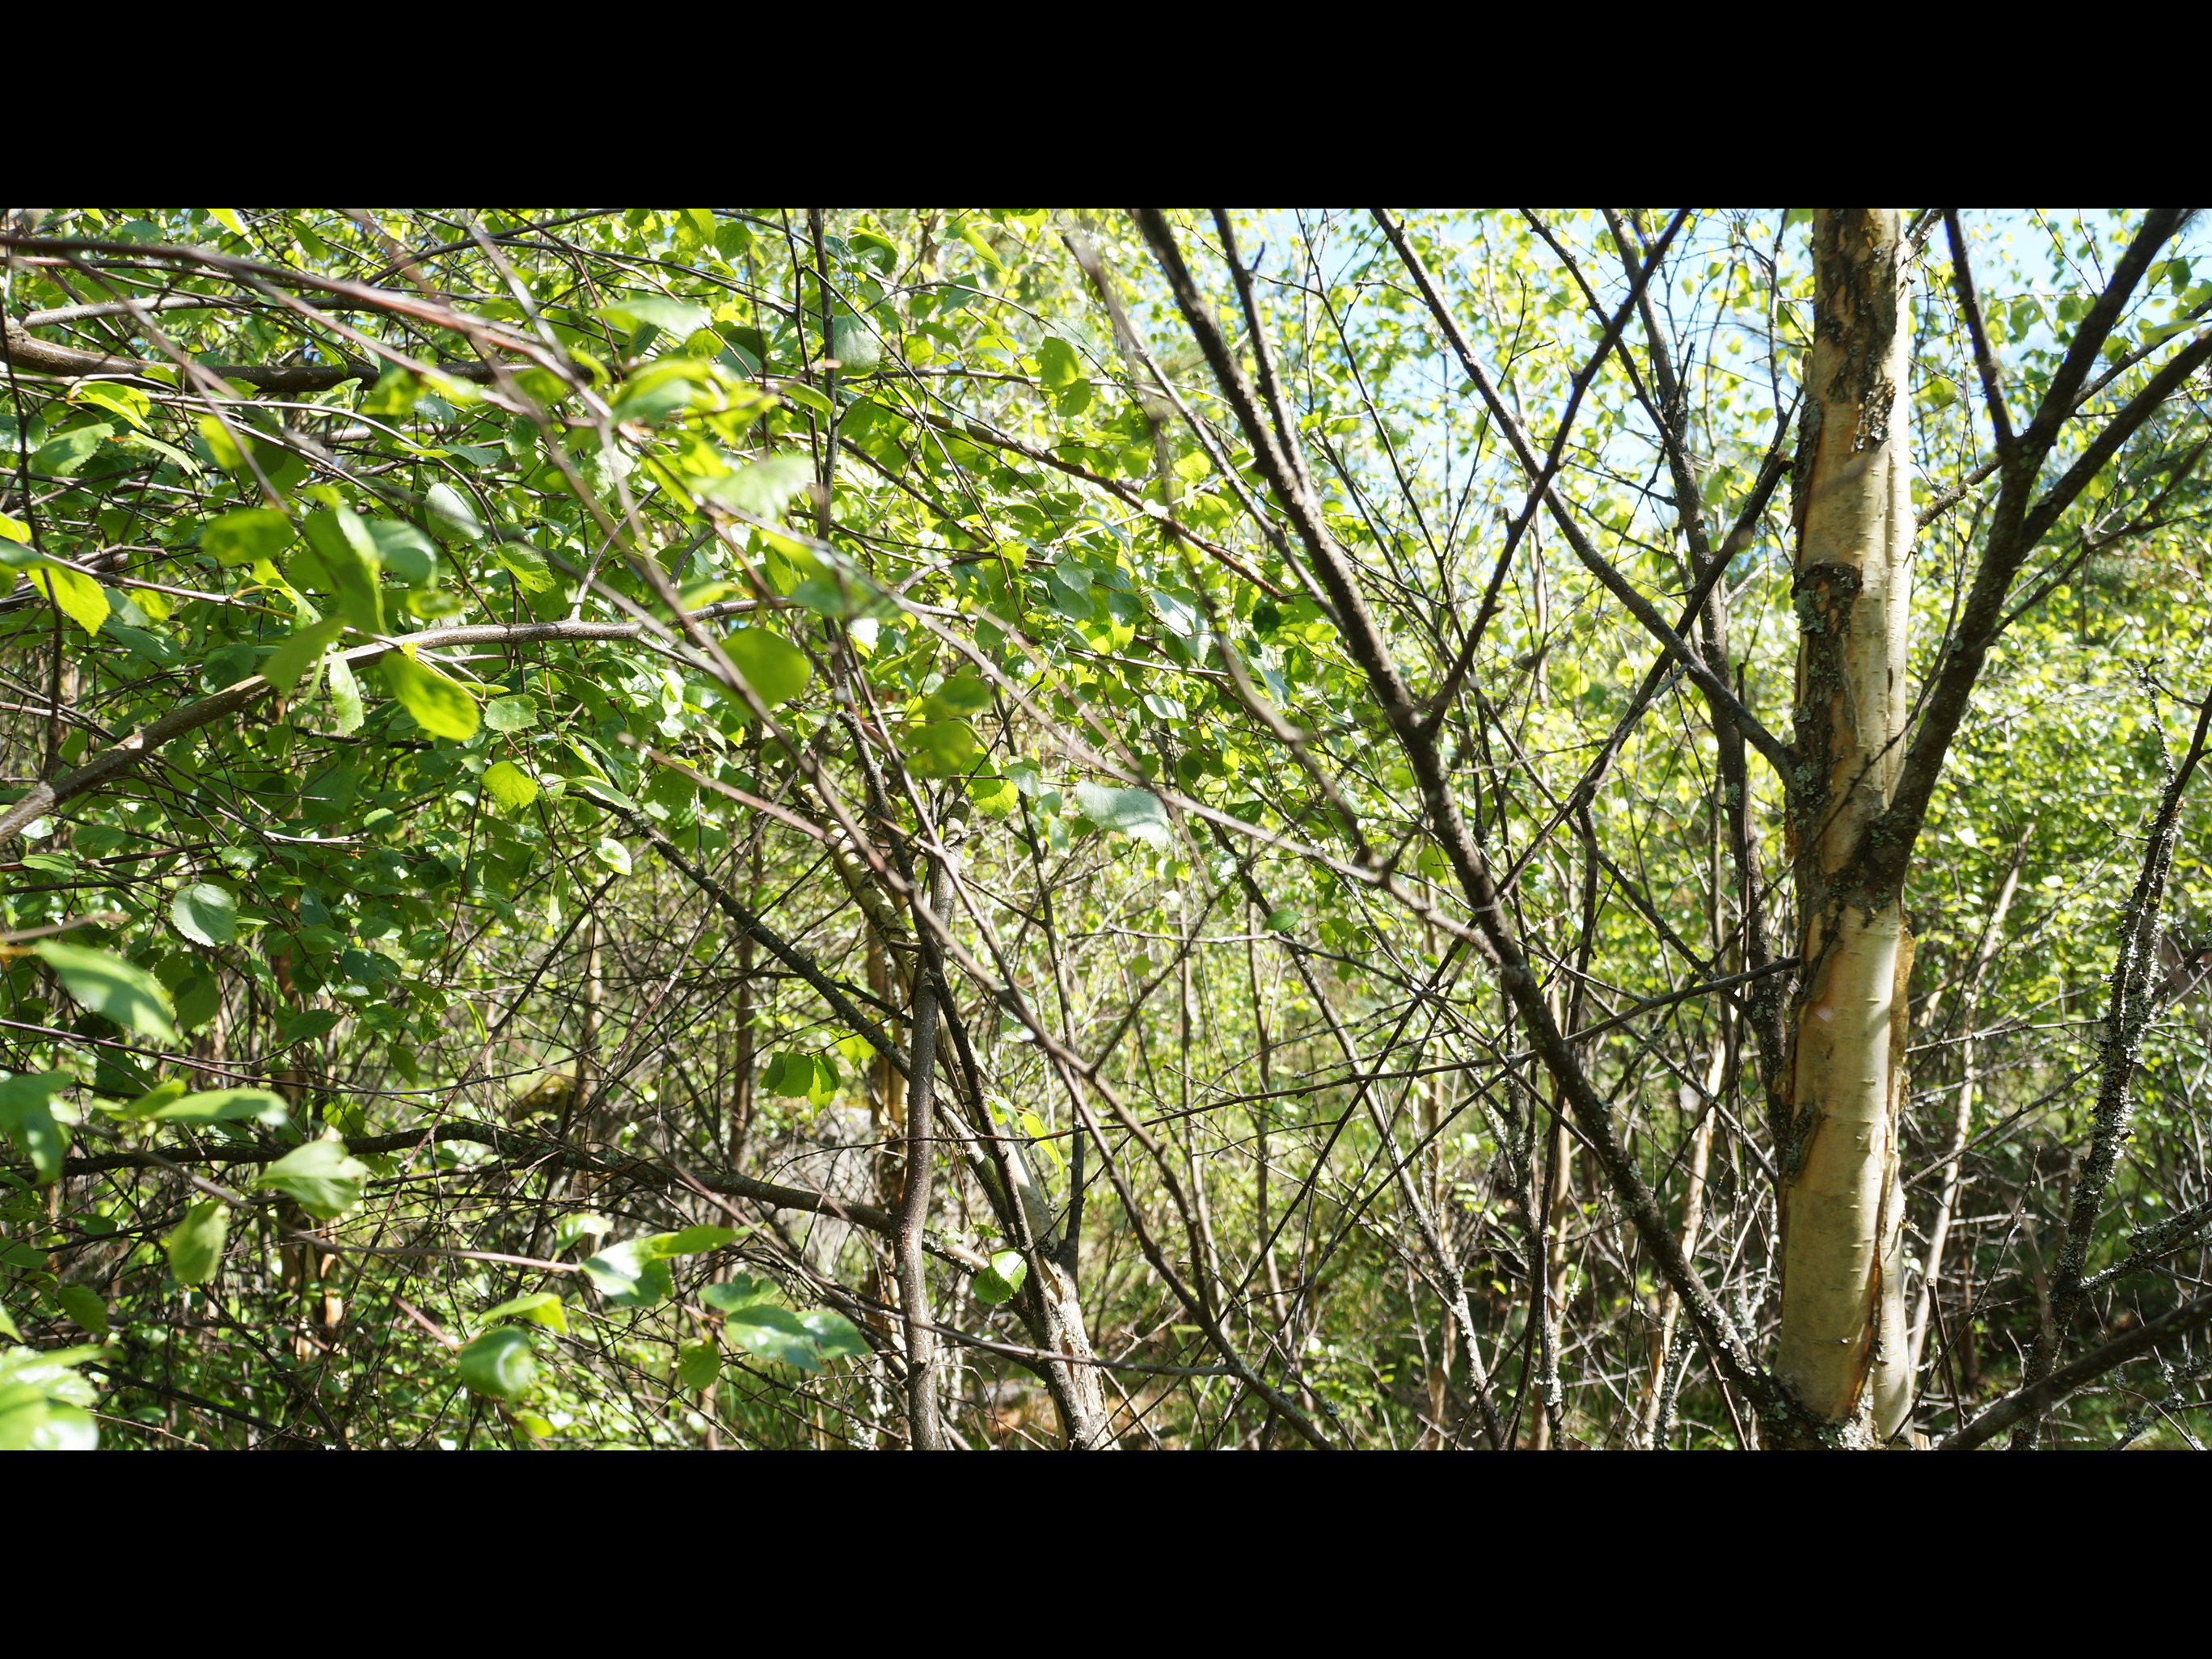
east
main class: Woodland
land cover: Broadleaved woodland
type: boreal forest
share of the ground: > 75 %
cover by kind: broadleaved forest trees 85 %, herbaceous plants 10 %, coniferous forest trees 5 %
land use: Forestry
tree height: < 5 m
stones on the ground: 10 - 25 %
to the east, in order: Broadleaved woodland; Ditches and canals; Temporary grasslands; Ditches and canals; Temporary grasslands; Ditches and canals; Temporary grasslands
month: June
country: FI
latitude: 64.2213
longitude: 23.9317
